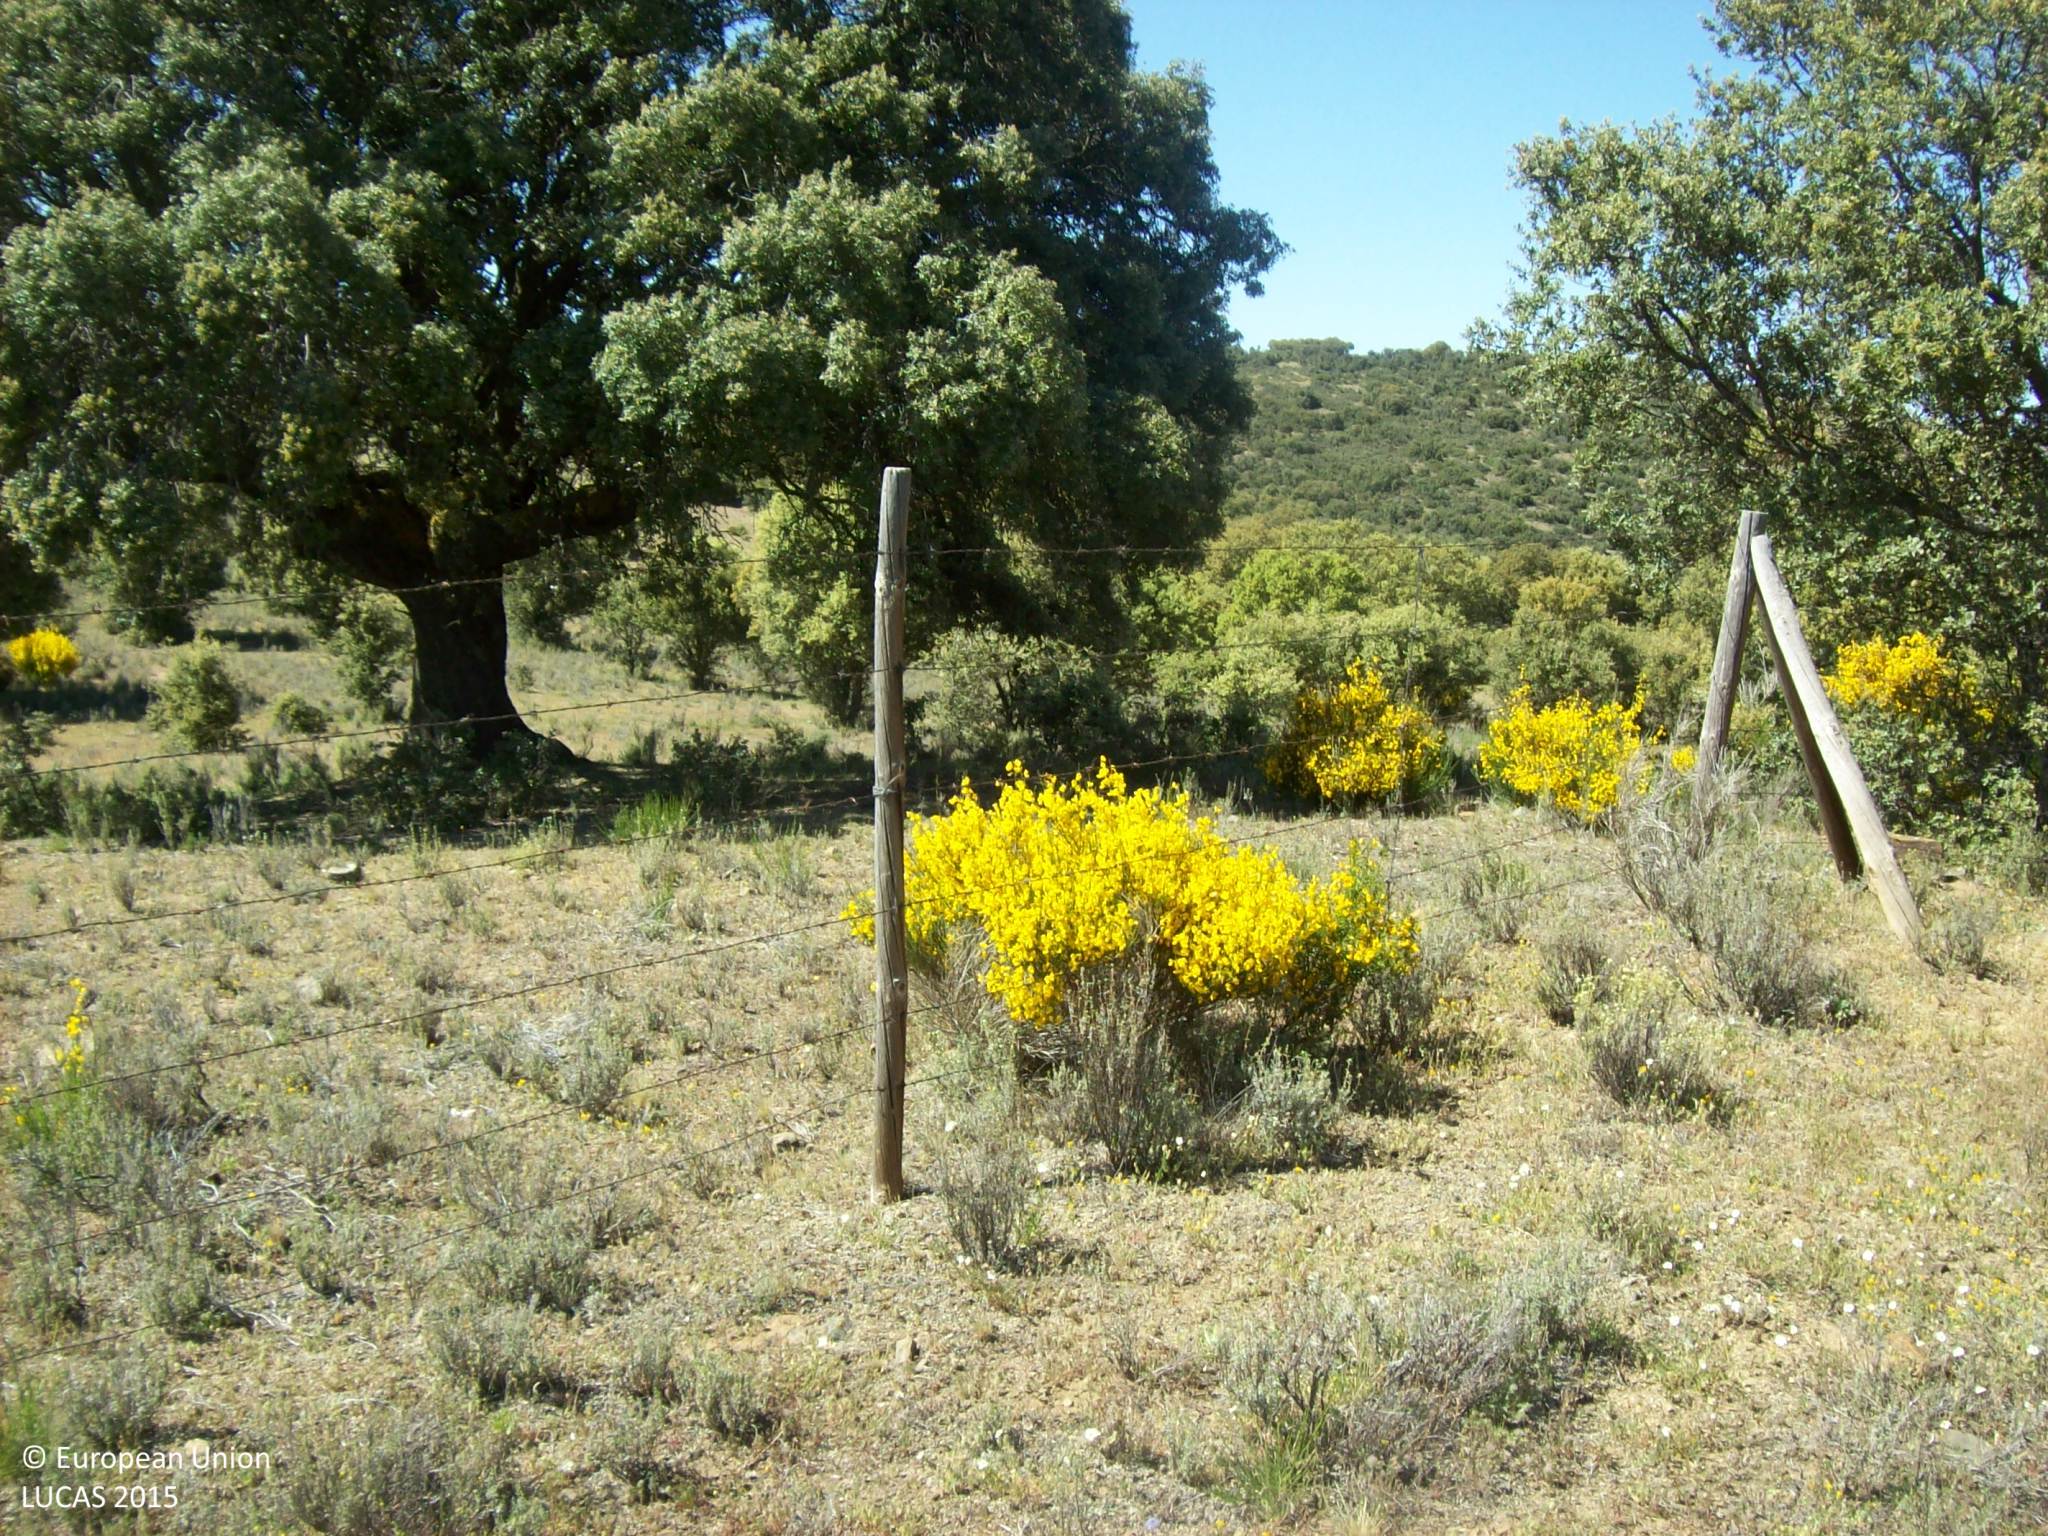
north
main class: Woodland
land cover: Broadleaved woodland
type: acidophilous oak and oak-birch forest
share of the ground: 10 - 25 %
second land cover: Shrubland without tree cover
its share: 50 - 75 %
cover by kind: shrubs 40 %, herbaceous plants 40 %, broadleaved forest trees 10 %, lichens and mosses 10 %
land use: Forestry
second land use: Agriculture (excluding fallow land and kitchen gardens)
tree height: > 5 m
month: May
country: ES
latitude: 40.7275
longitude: -4.9674
